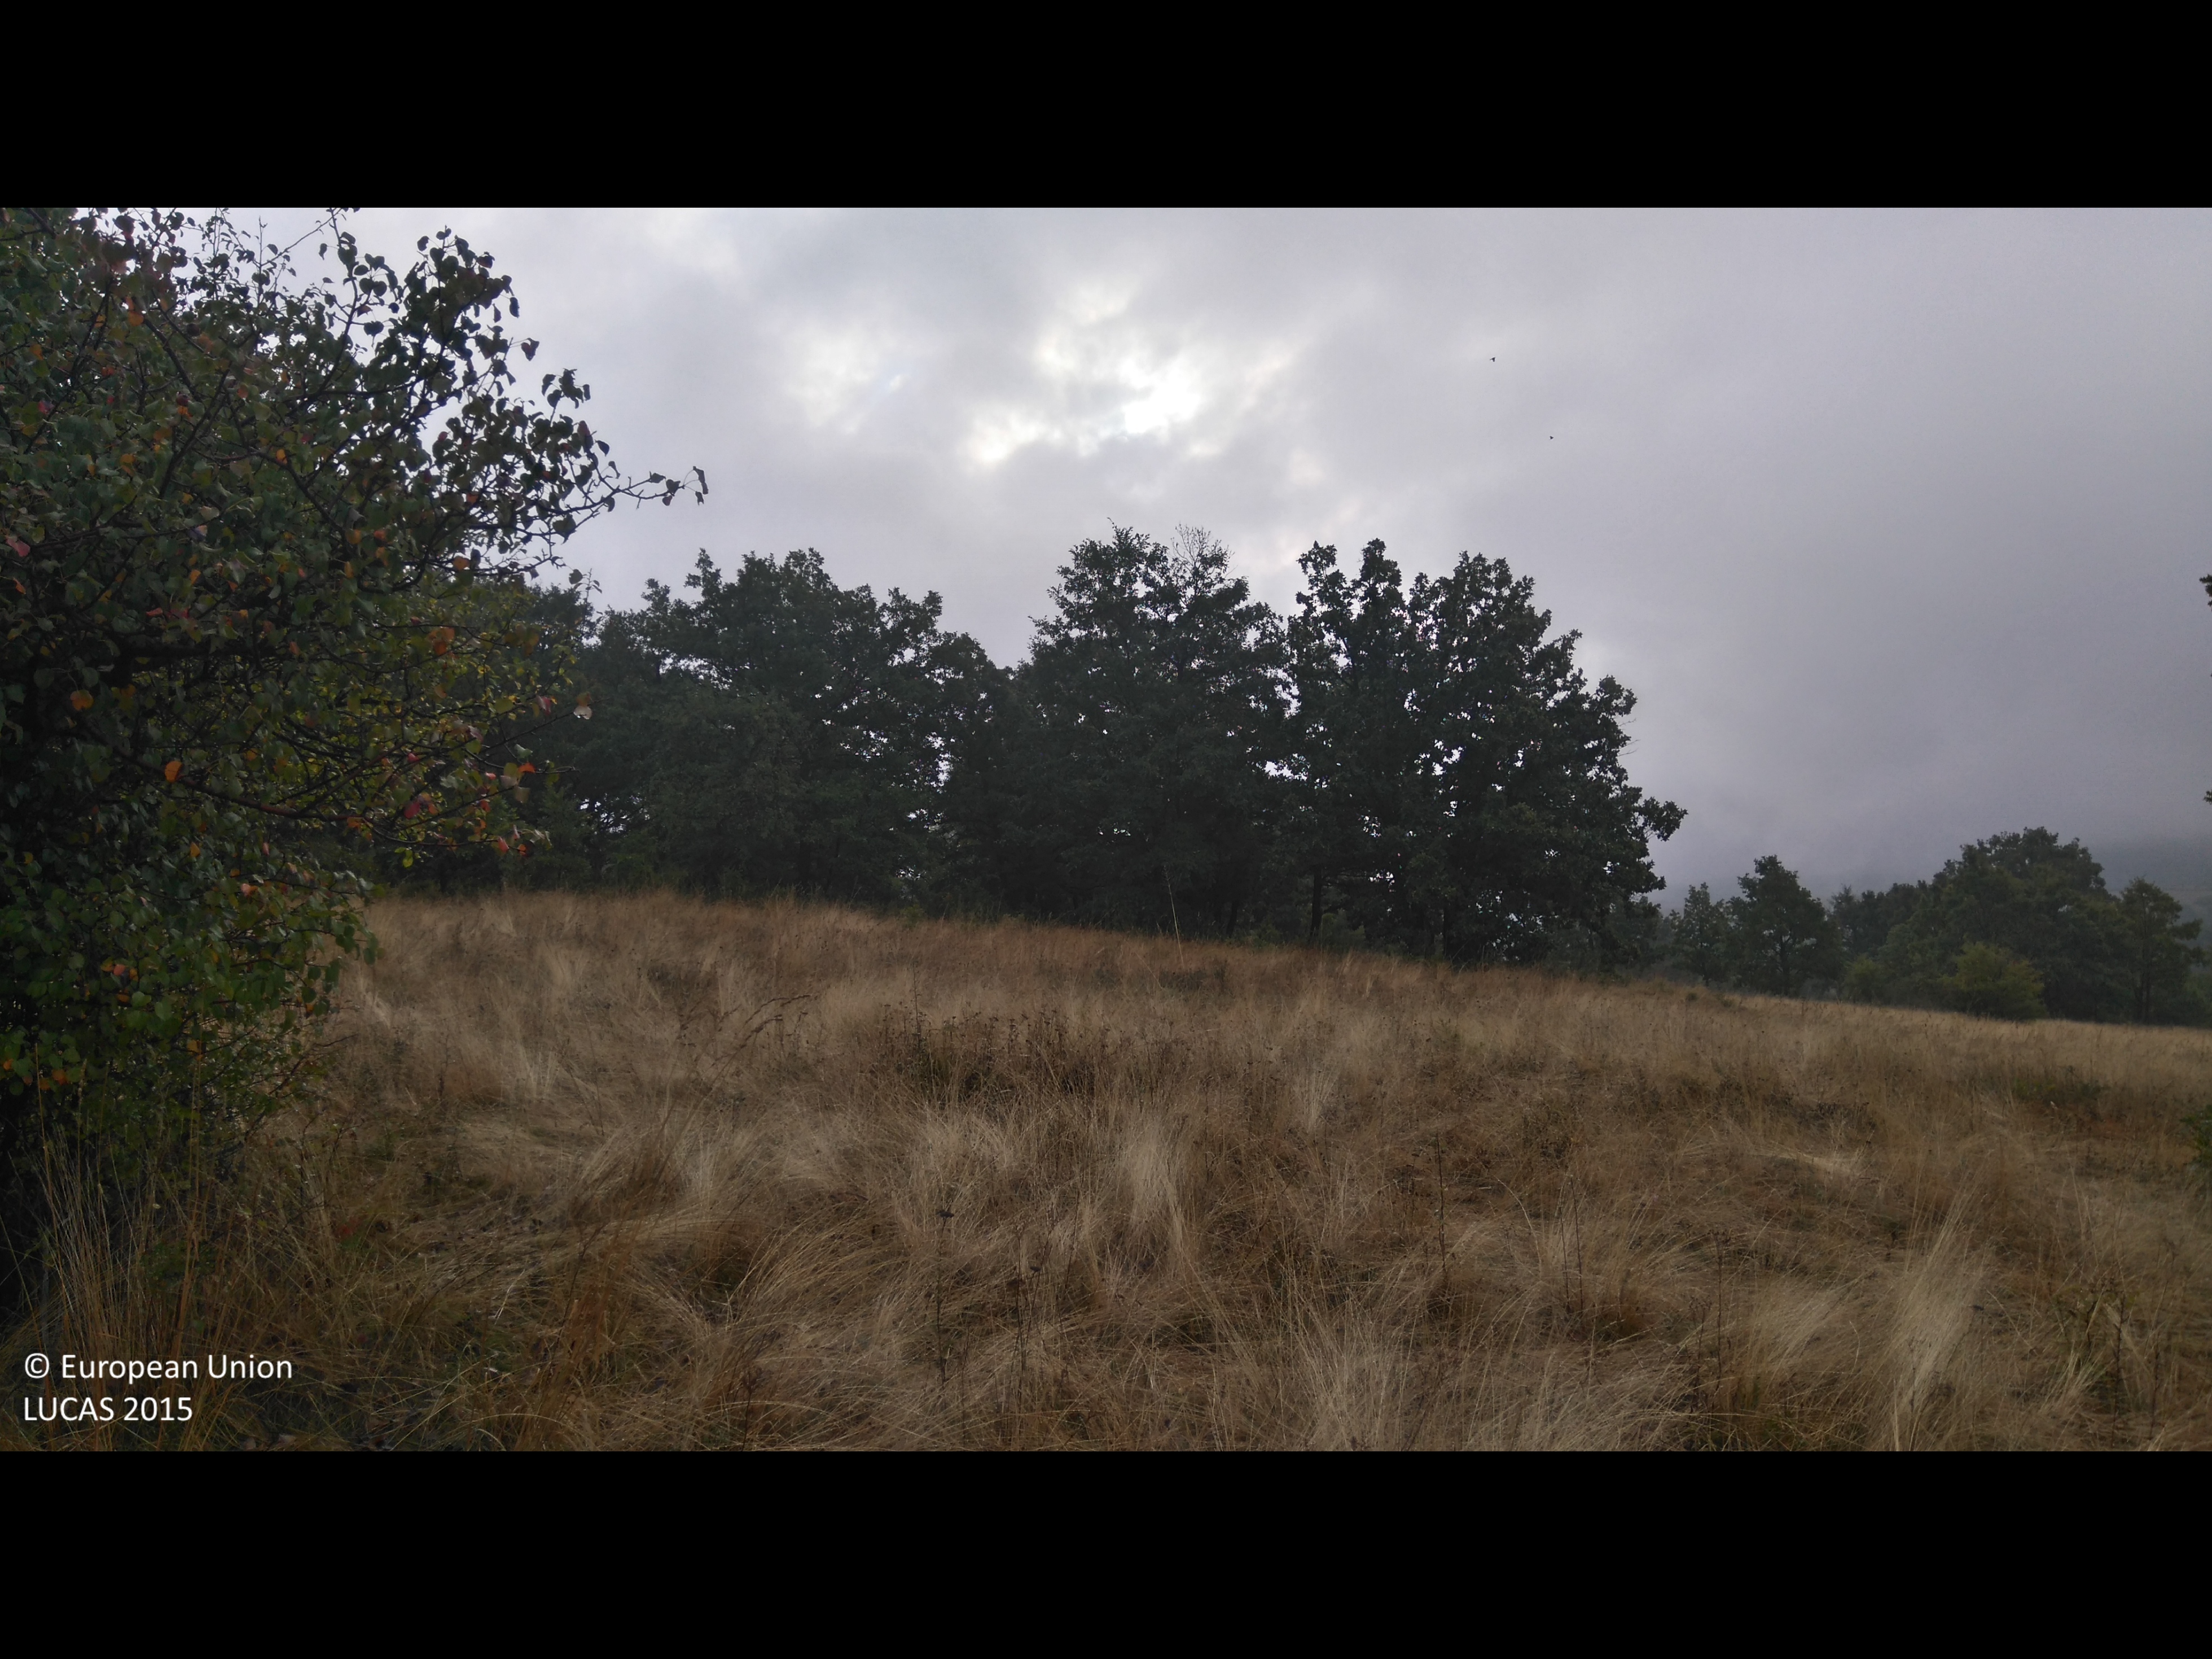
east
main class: Grassland
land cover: Grassland with sparse tree/shrub cover
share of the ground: > 75 %
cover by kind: herbaceous plants 90 %, broadleaved forest trees 5 %, shrubs 5 %
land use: Agriculture (excluding fallow land and kitchen gardens)
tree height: > 5 m
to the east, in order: Grassland with sparse tree/shrub cover; Broadleaved woodland; Grassland with sparse tree/shrub cover; Broadleaved woodland
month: October
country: BG
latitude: 42.6504
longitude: 23.8373
